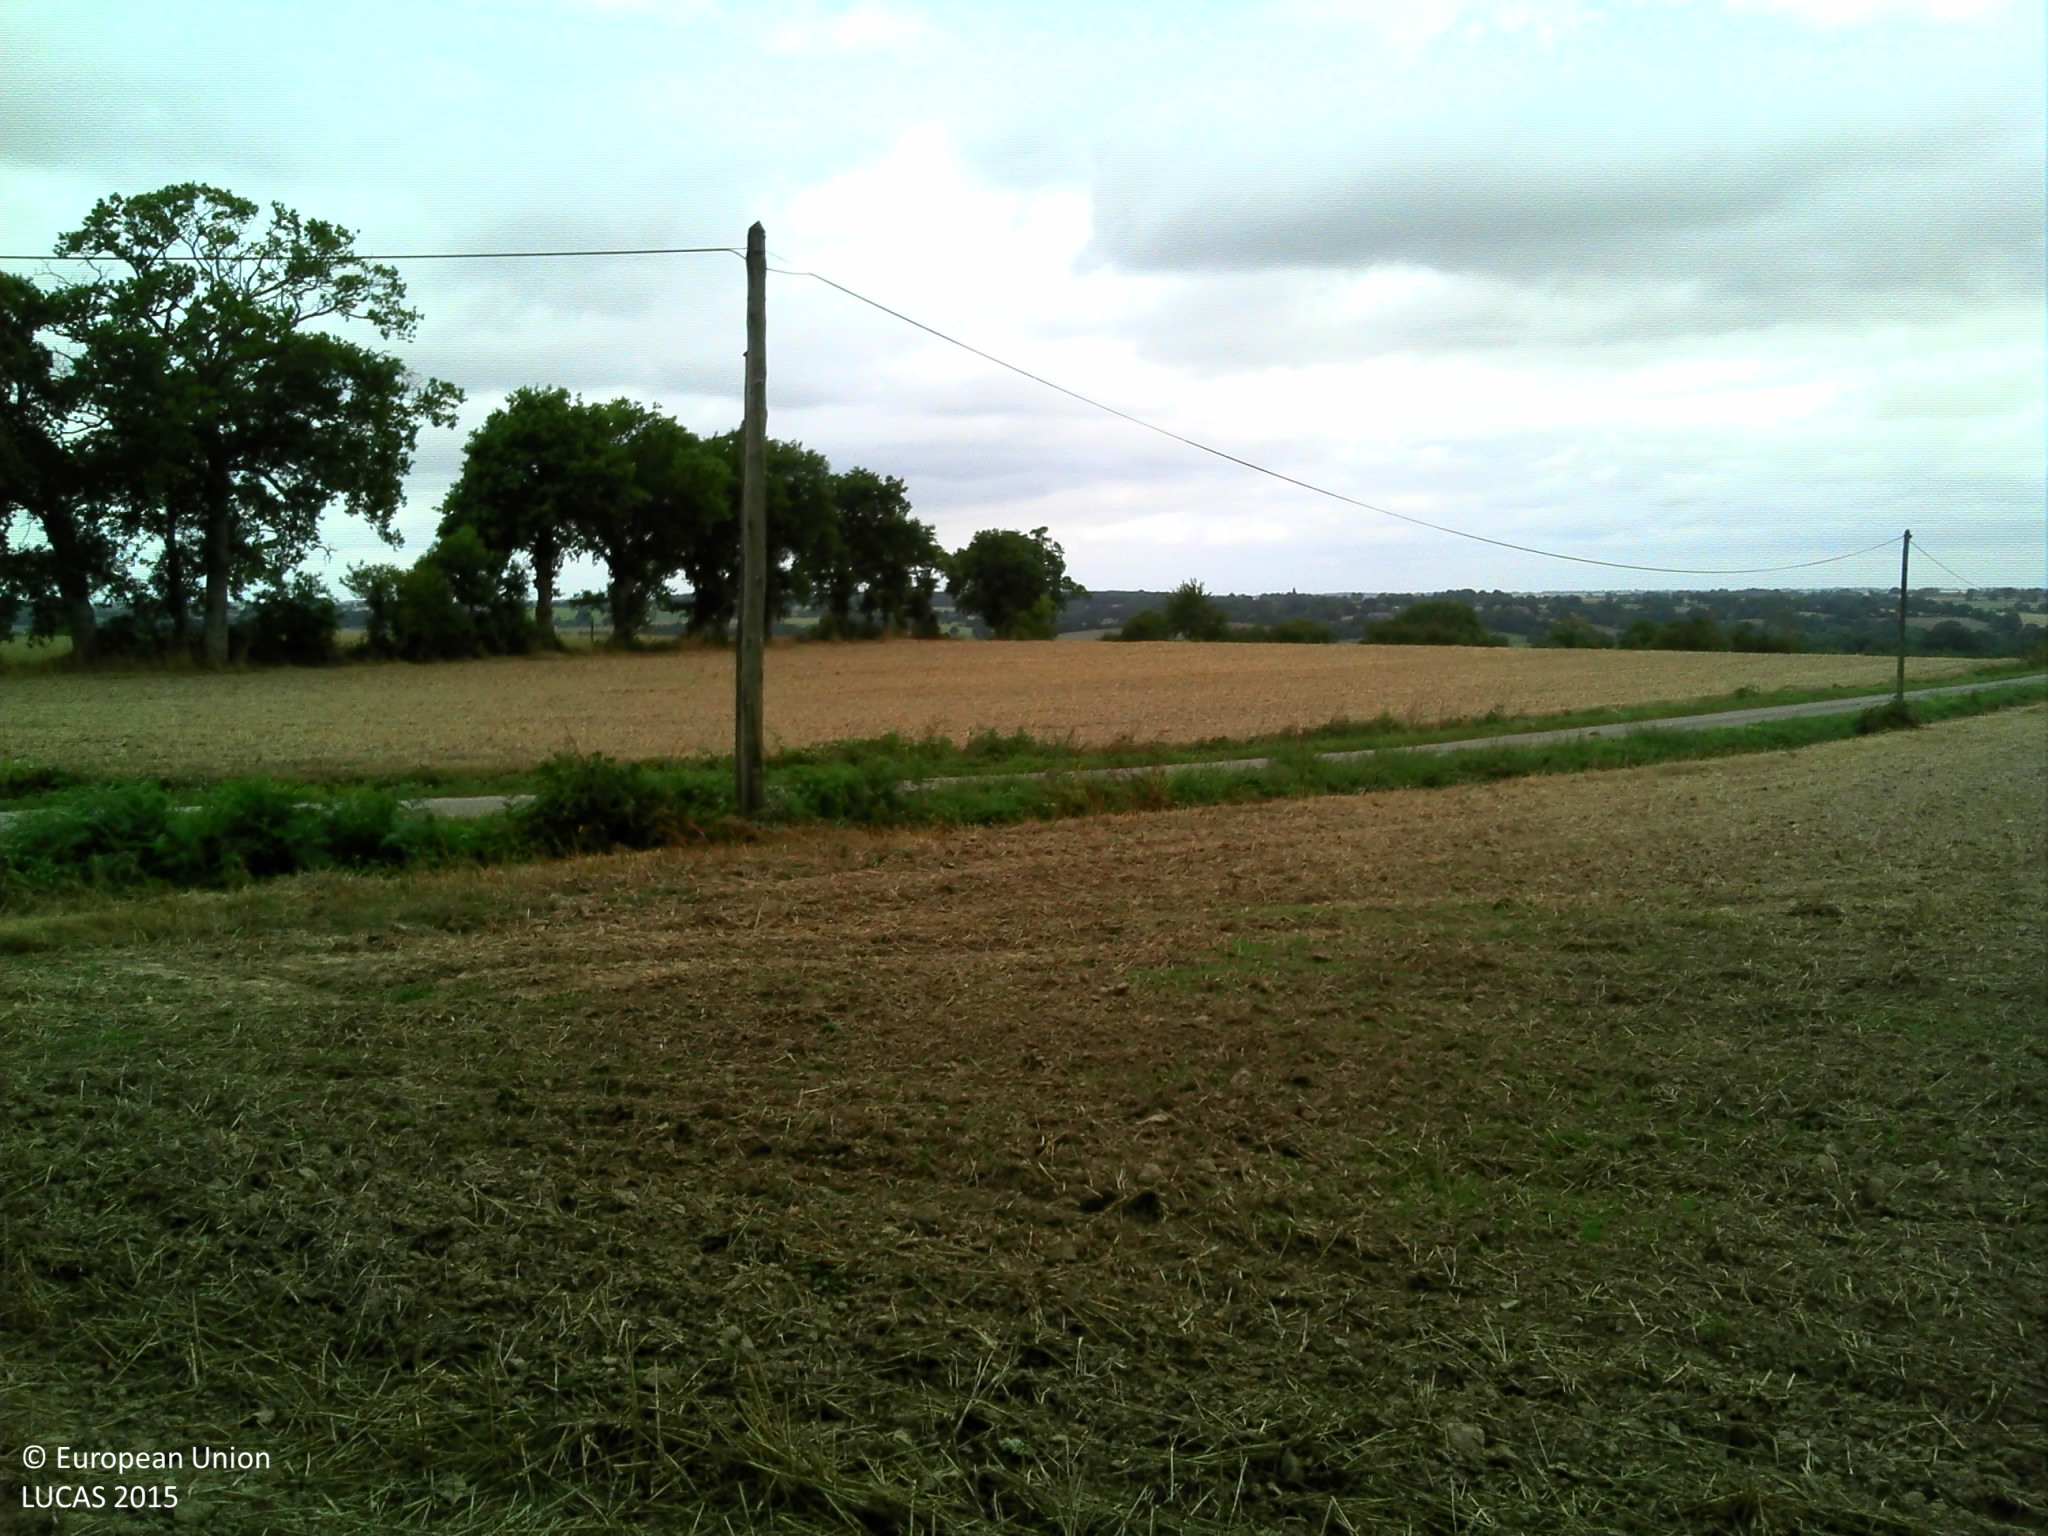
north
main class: Cropland
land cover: Common wheat
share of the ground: > 75 %
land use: Agriculture (excluding fallow land and kitchen gardens)
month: August
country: FR
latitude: 47.8110
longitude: -1.4074
